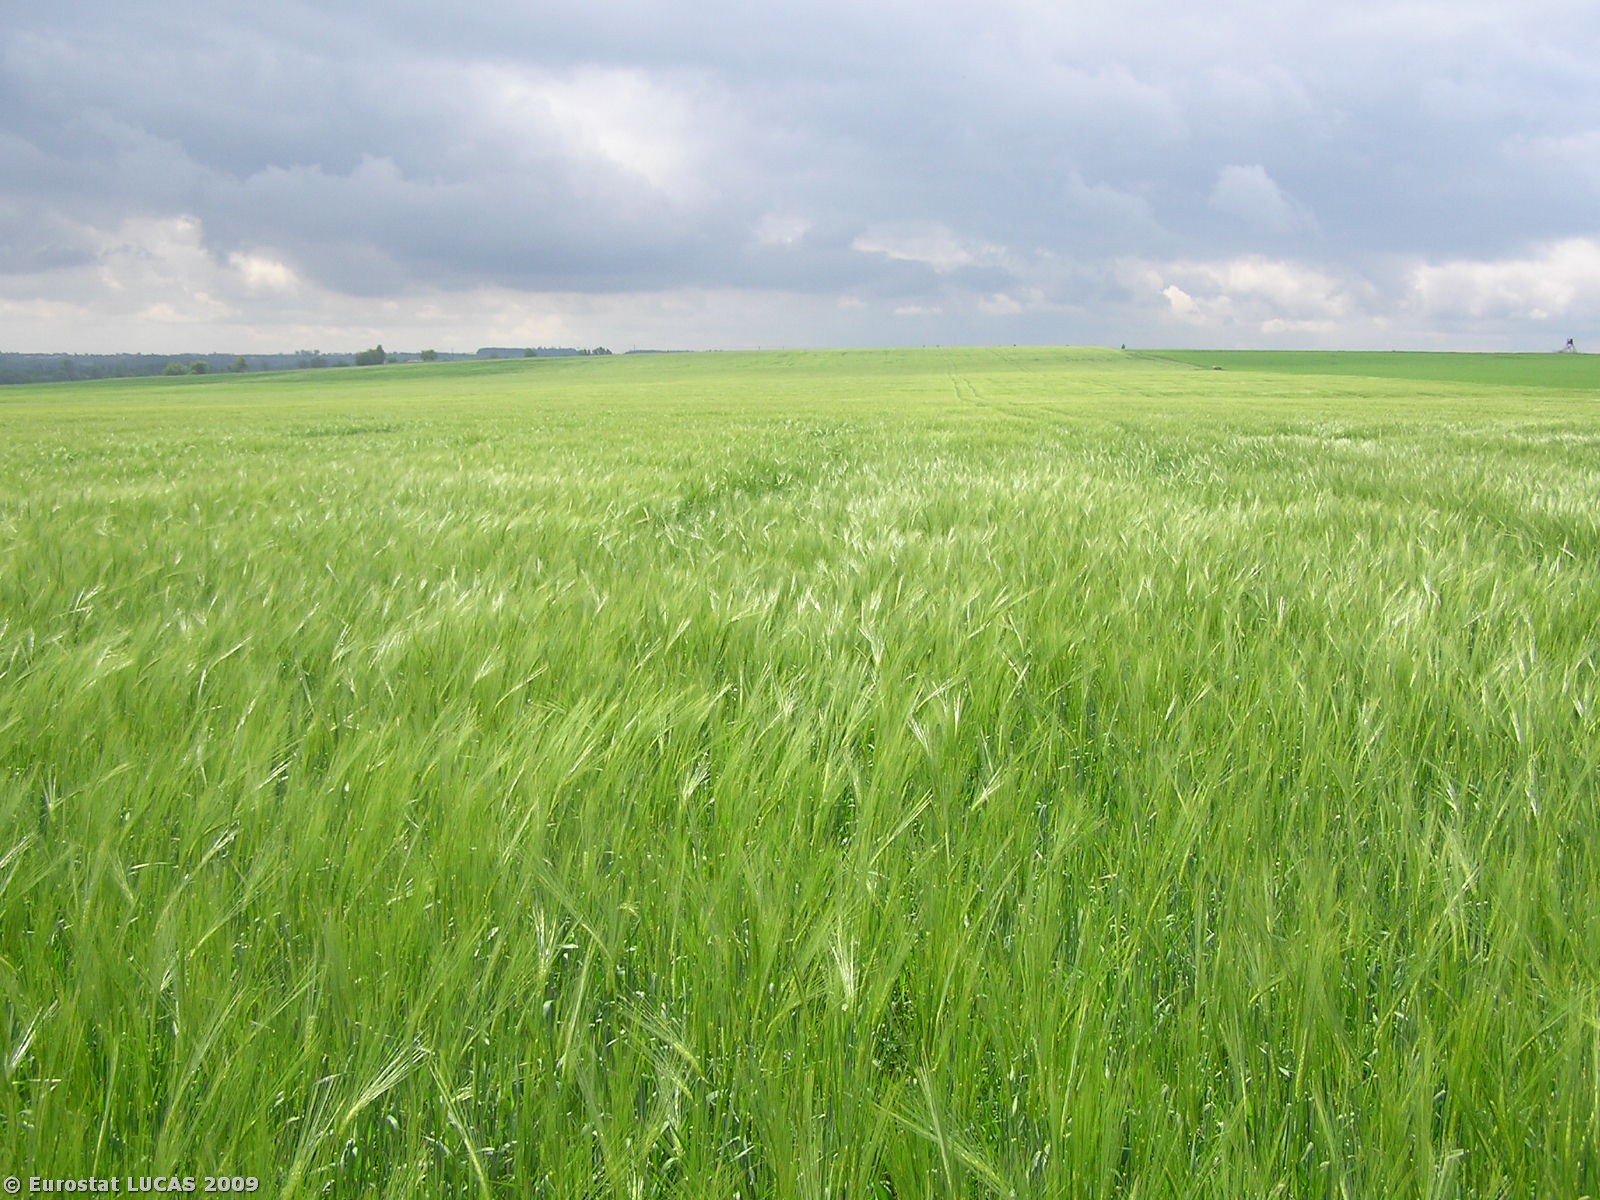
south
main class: Cropland
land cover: Barley
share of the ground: > 75 %
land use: Agriculture (excluding fallow land and kitchen gardens)
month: May
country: CZ
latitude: 49.4432
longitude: 14.5943
